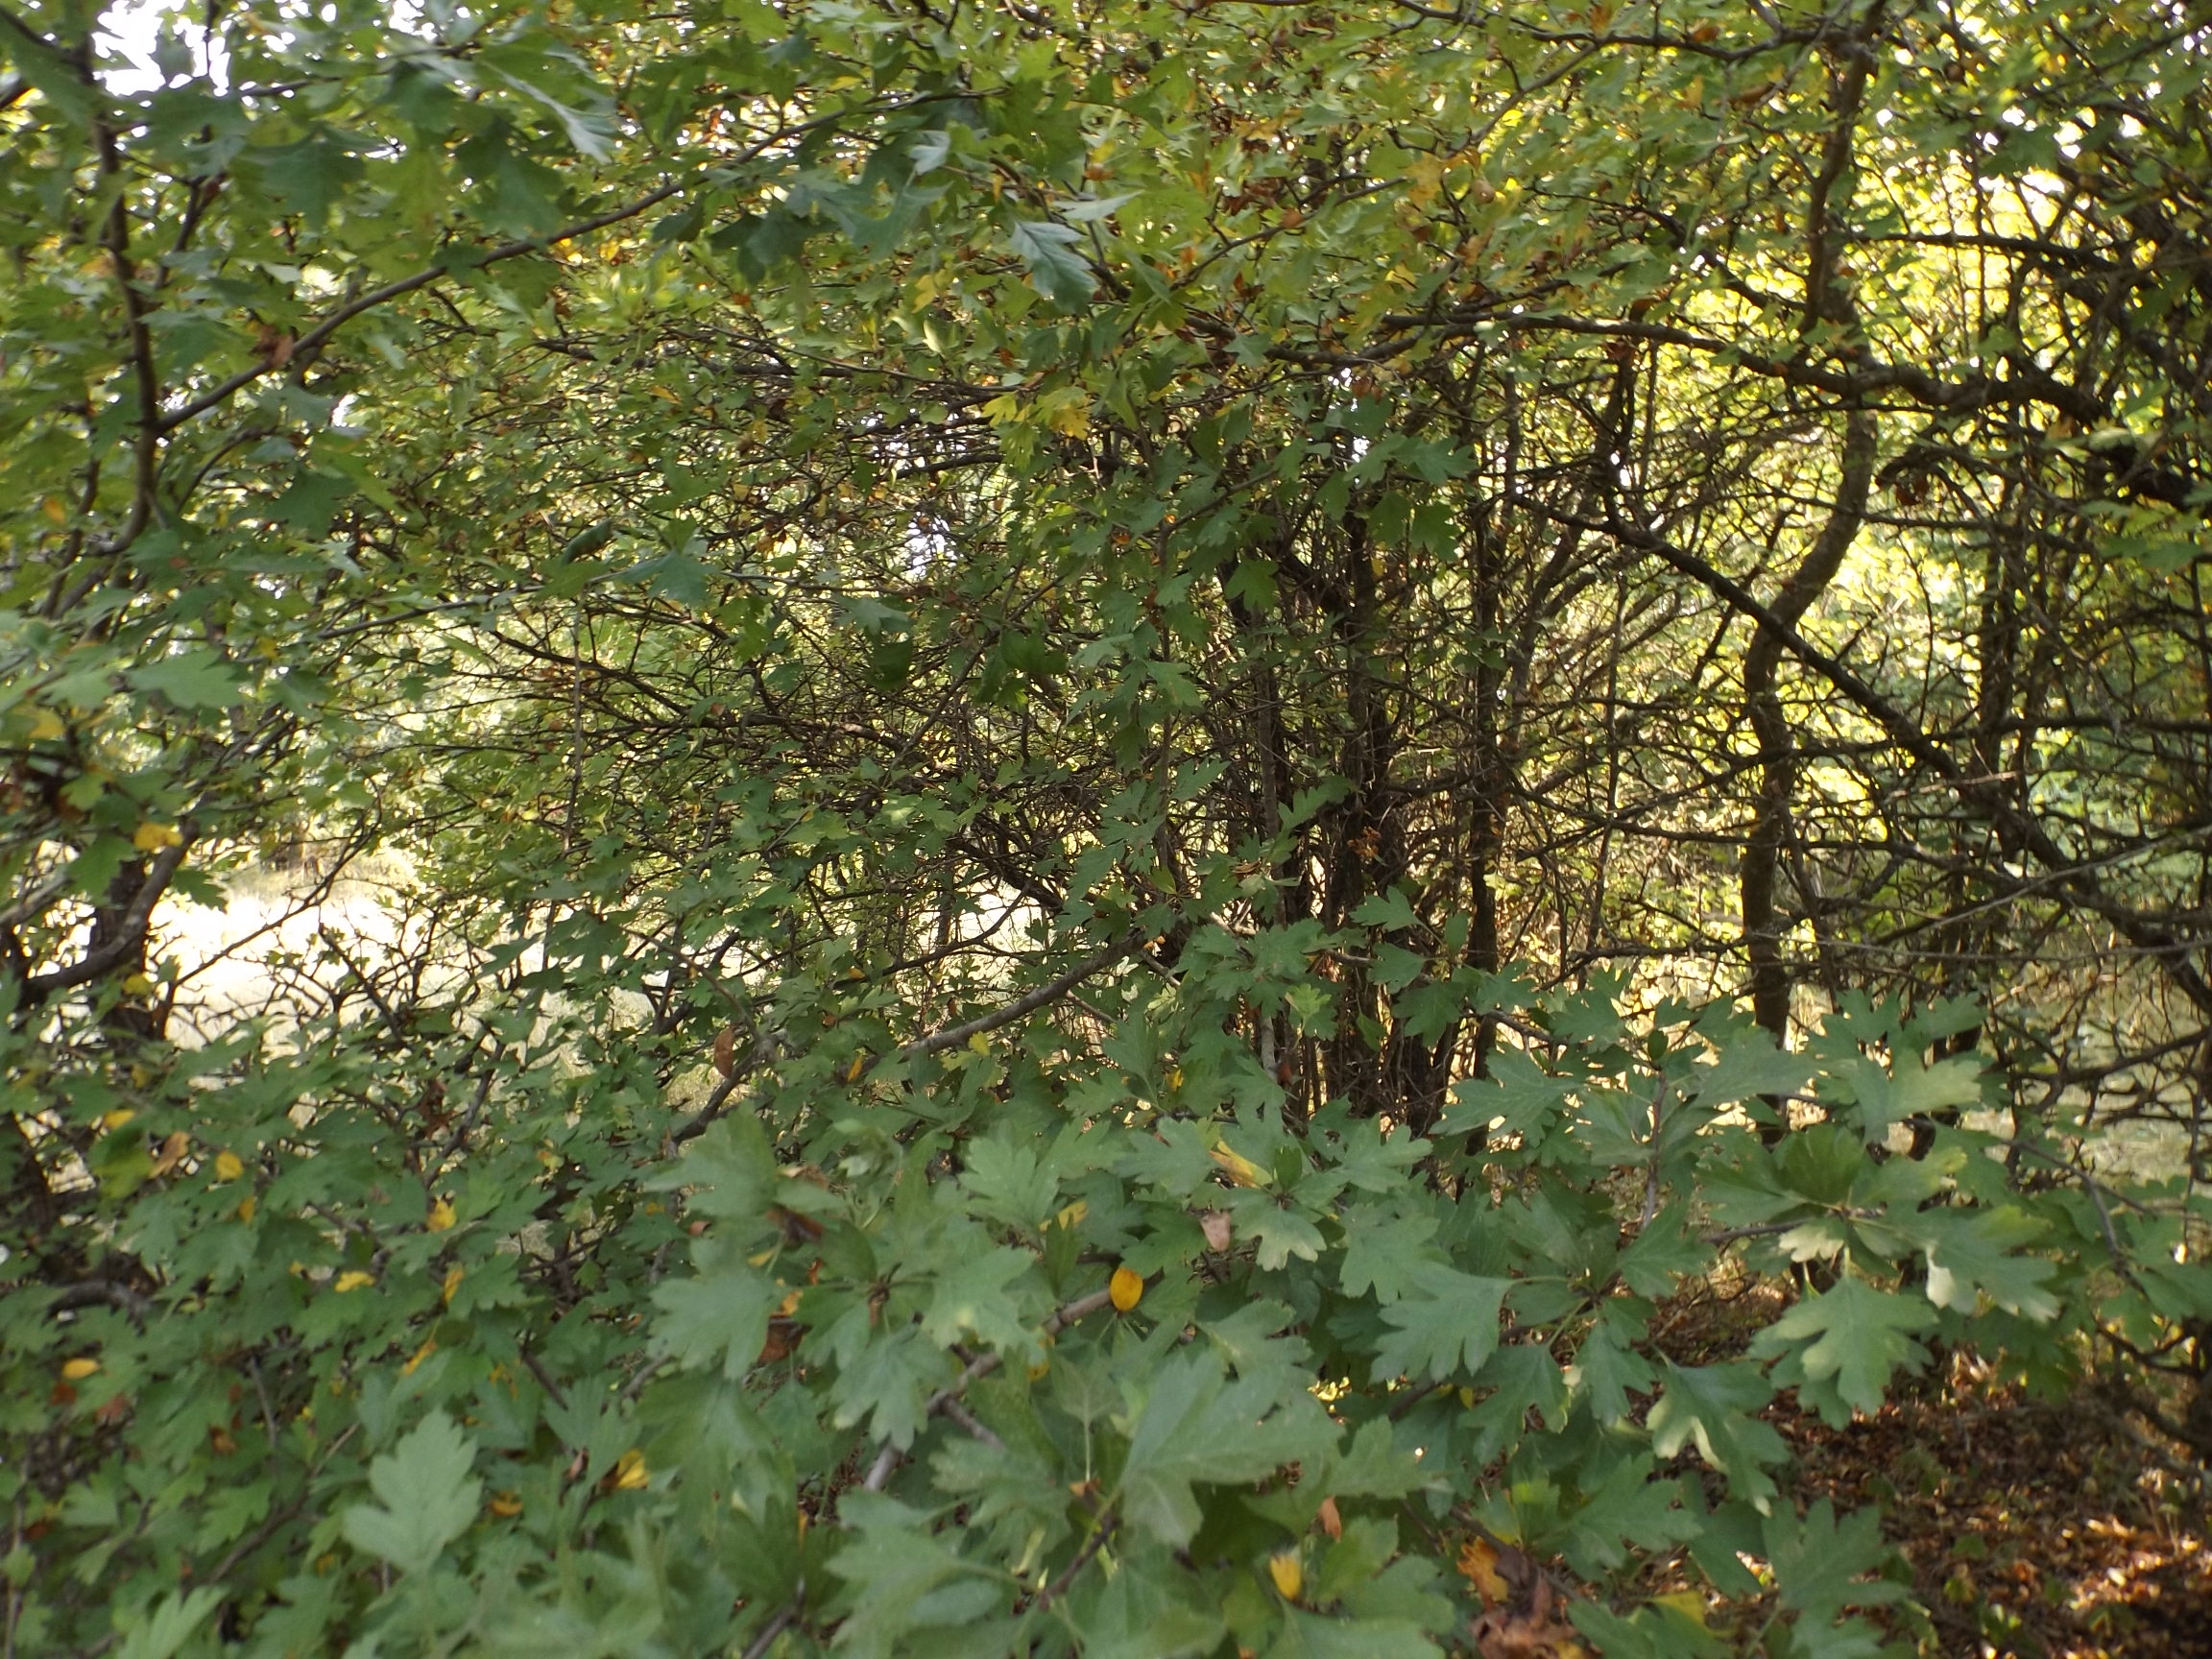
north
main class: Woodland
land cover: Broadleaved woodland
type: mesophytic deciduous forest
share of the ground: 50 - 75 %
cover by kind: broadleaved forest trees 60 %, herbaceous plants 30 %, shrubs 10 %
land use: Forestry
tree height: > 5 m
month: July
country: BG
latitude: 43.4938
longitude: 27.6075
